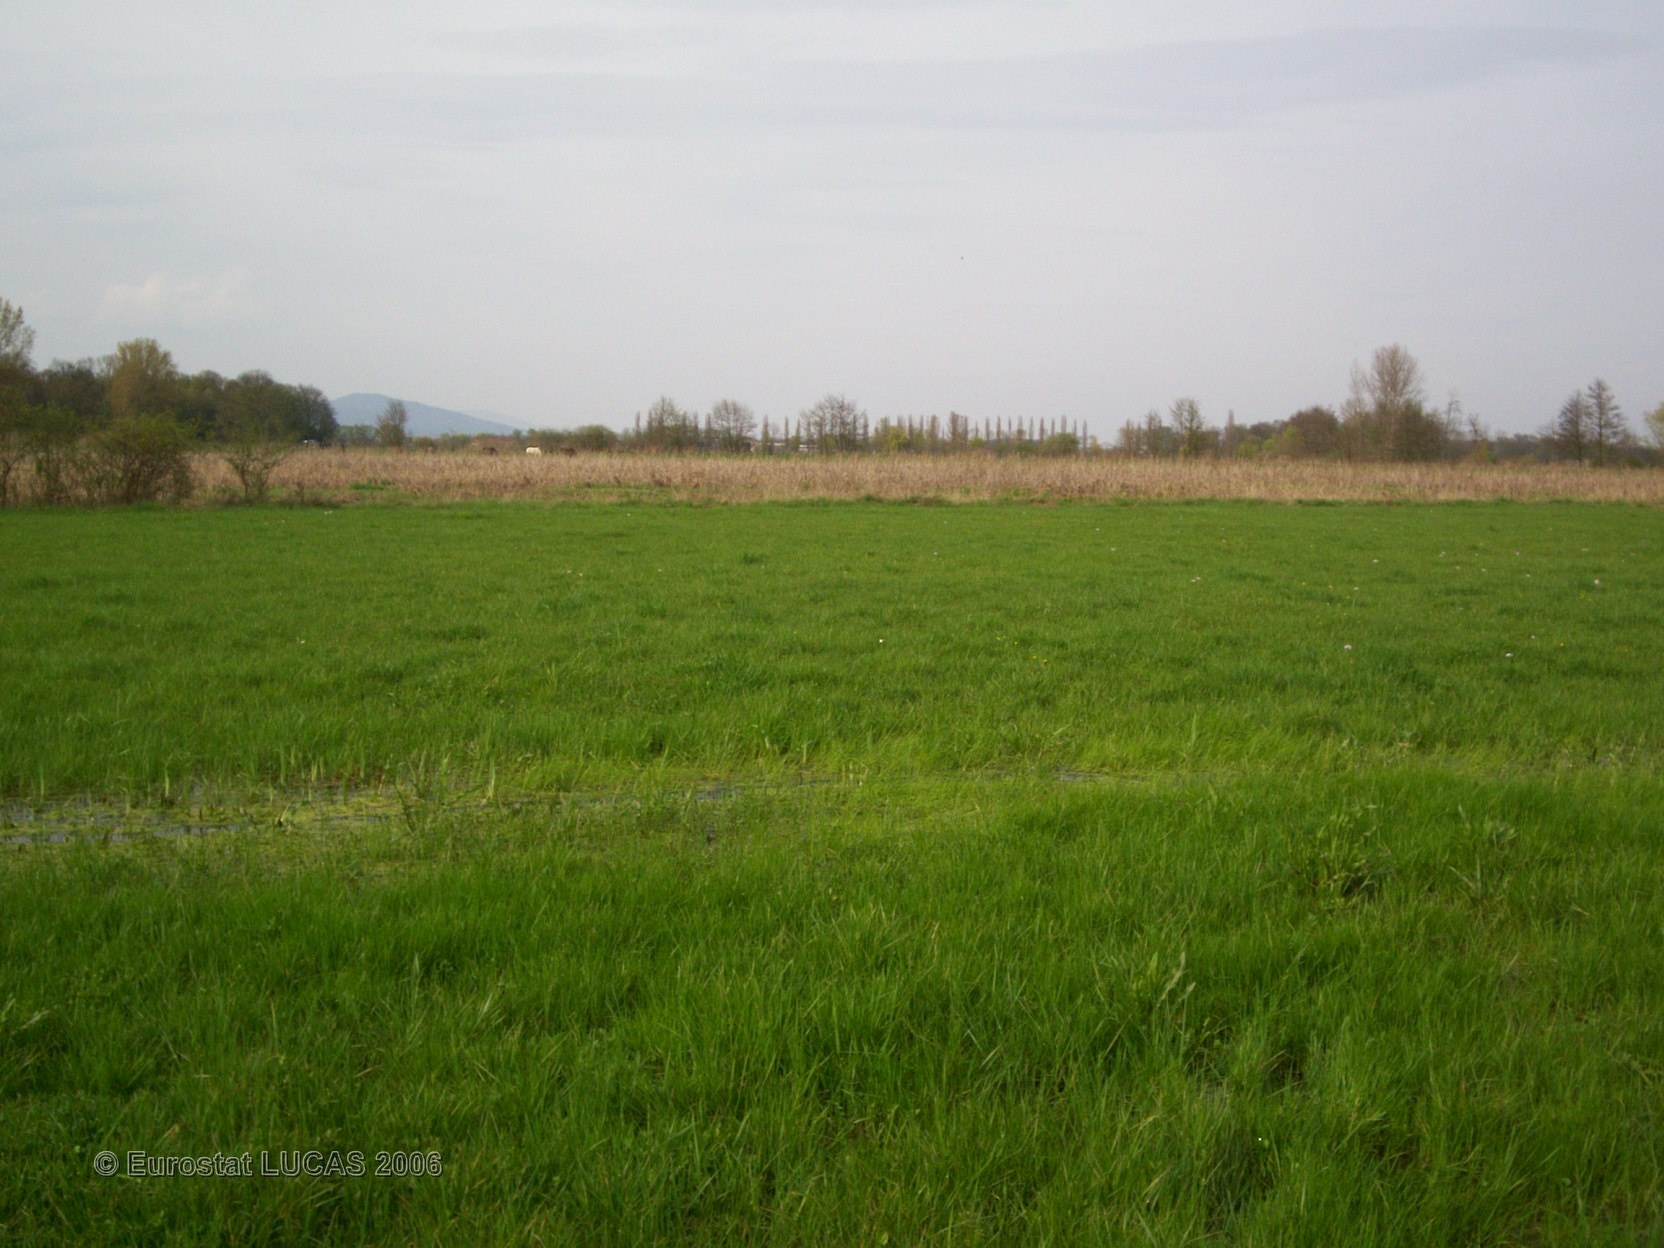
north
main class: Grassland
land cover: Grassland without tree/shrub cover
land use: Agriculture (excluding fallow land and kitchen gardens)
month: April
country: FR
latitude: 48.1750
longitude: 7.4056
